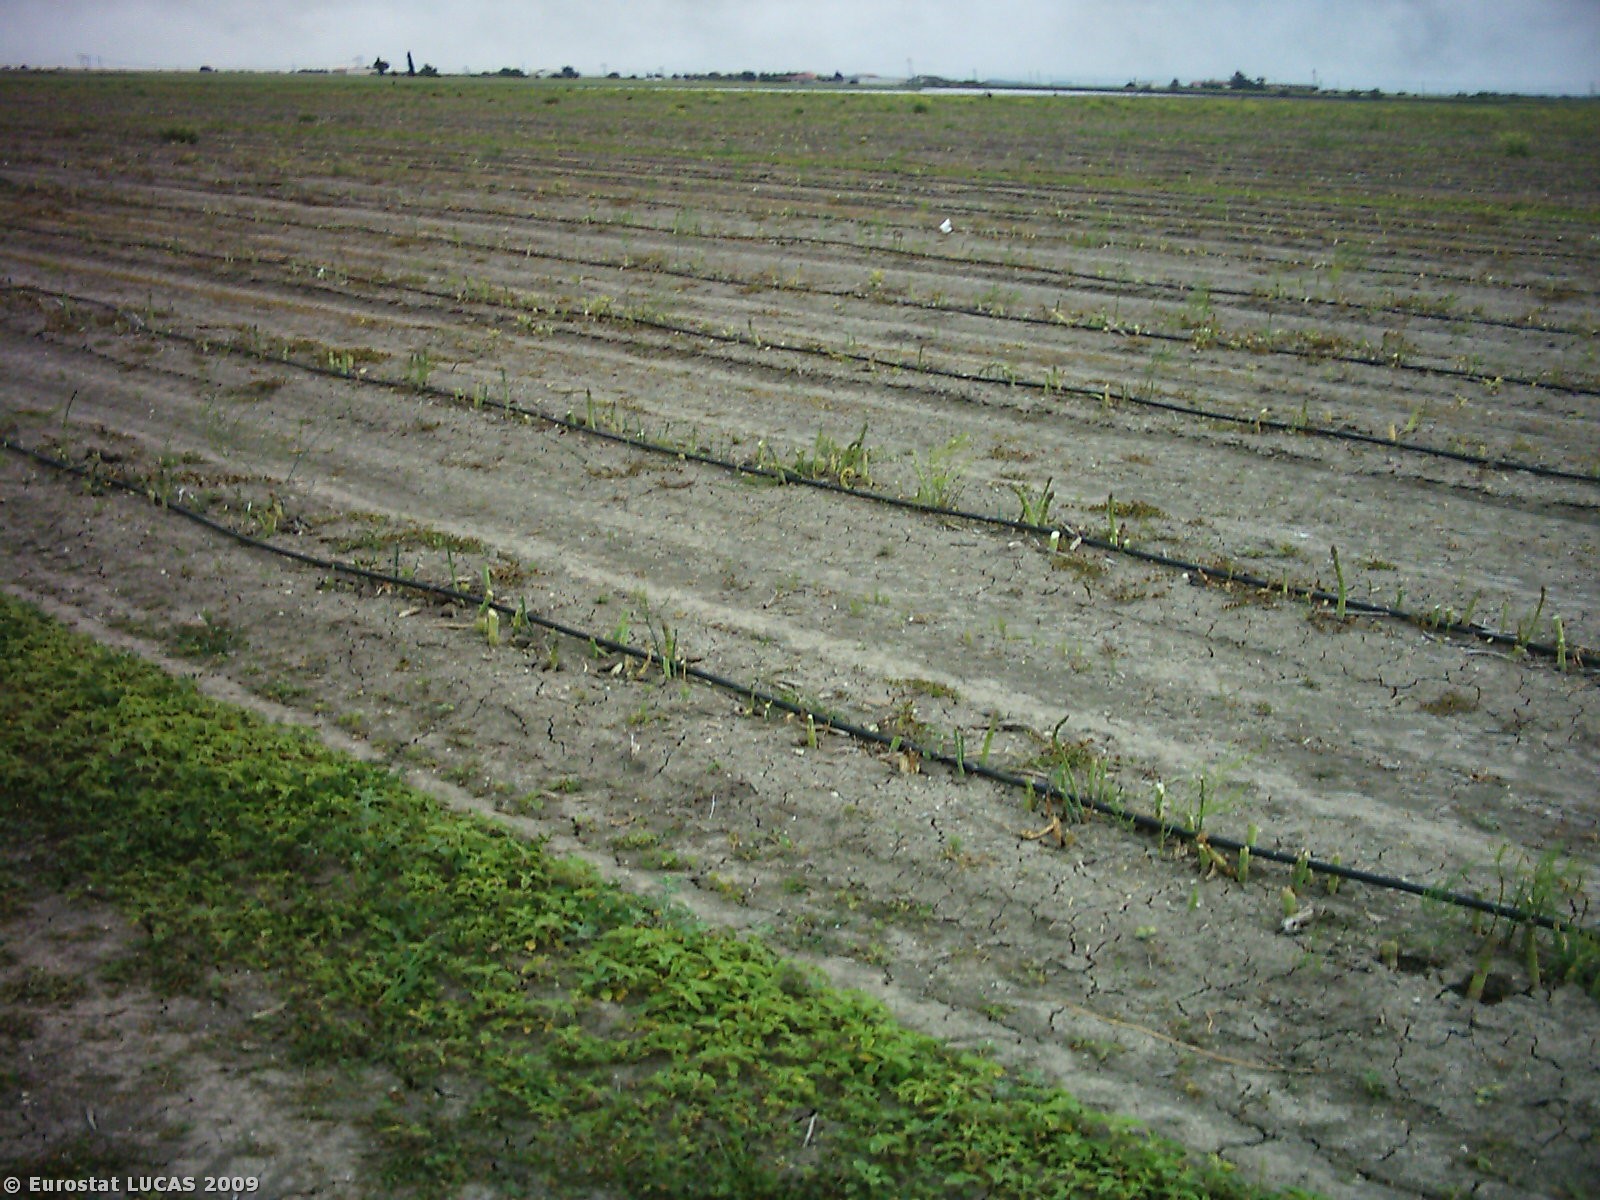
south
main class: Cropland
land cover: Other fresh vegetables
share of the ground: 10 - 25 %
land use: Agriculture (excluding fallow land and kitchen gardens)
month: May
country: IT
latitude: 41.4991
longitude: 15.6721
